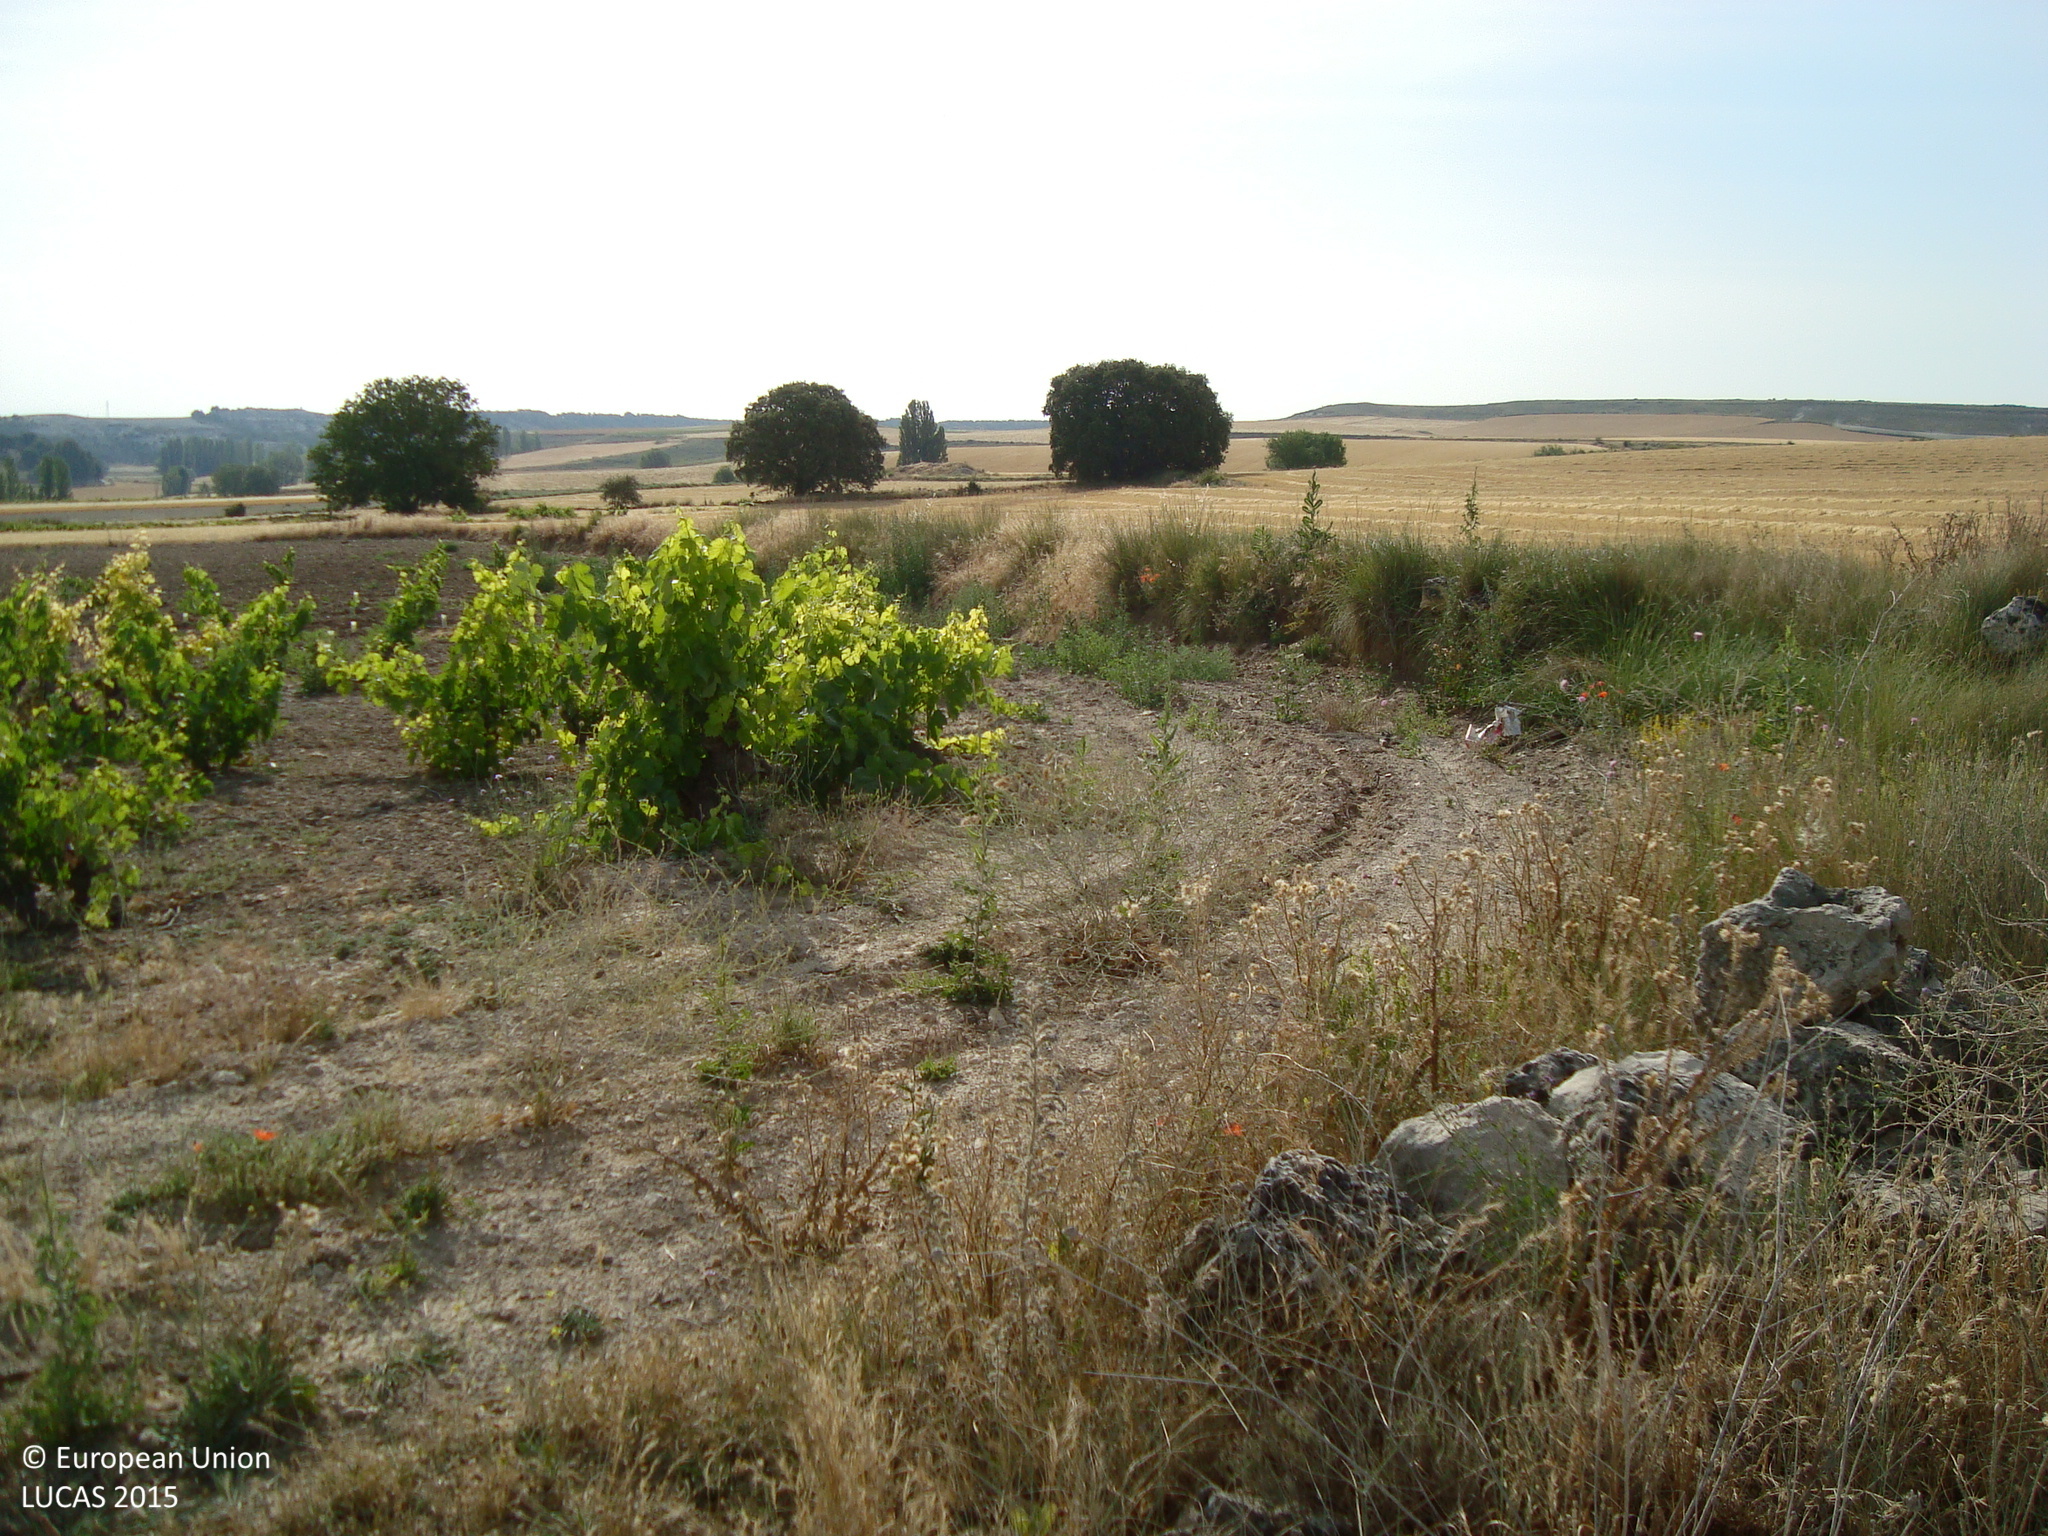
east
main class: Cropland
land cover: Vineyards
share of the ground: 50 - 75 %
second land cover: Other bare soil
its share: > 75 %
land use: Agriculture (excluding fallow land and kitchen gardens)
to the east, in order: Vineyards; Dry stone walls; Tracks; Vineyards; Barley; Grass margins; Barley; Grass margins; Barley; Abandoned hedges; Dry stone walls; Barley
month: July
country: ES
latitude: 41.7341
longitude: -4.2369
